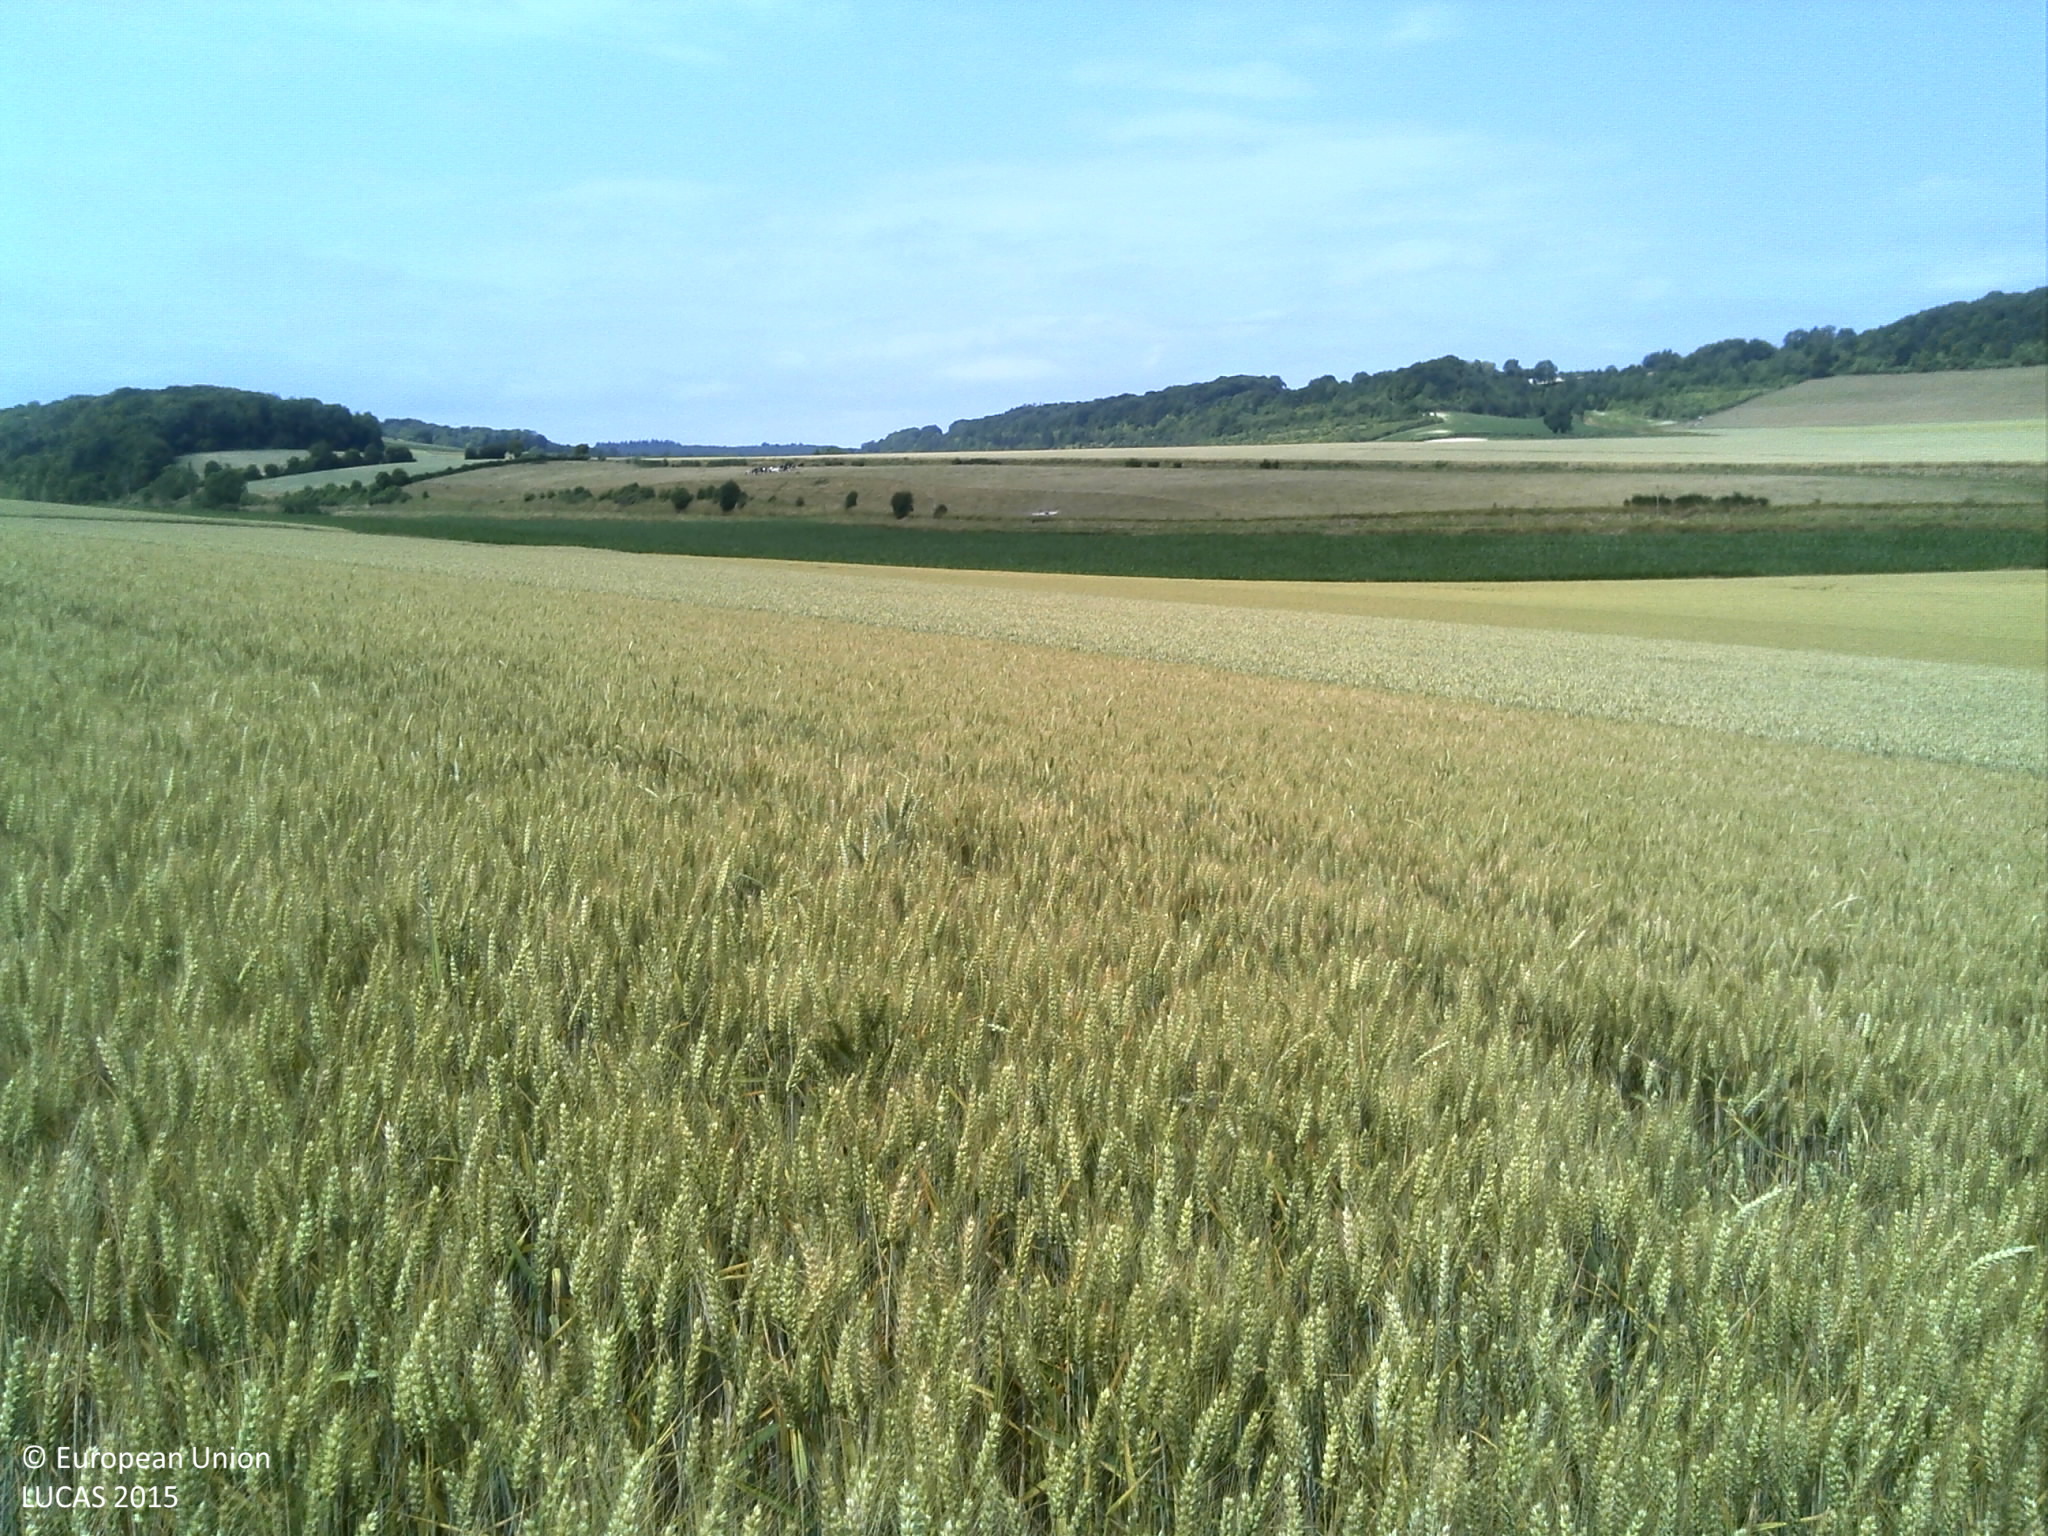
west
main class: Cropland
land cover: Durum wheat
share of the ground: > 75 %
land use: Agriculture (excluding fallow land and kitchen gardens)
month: July
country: FR
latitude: 49.8279
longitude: 1.7114
